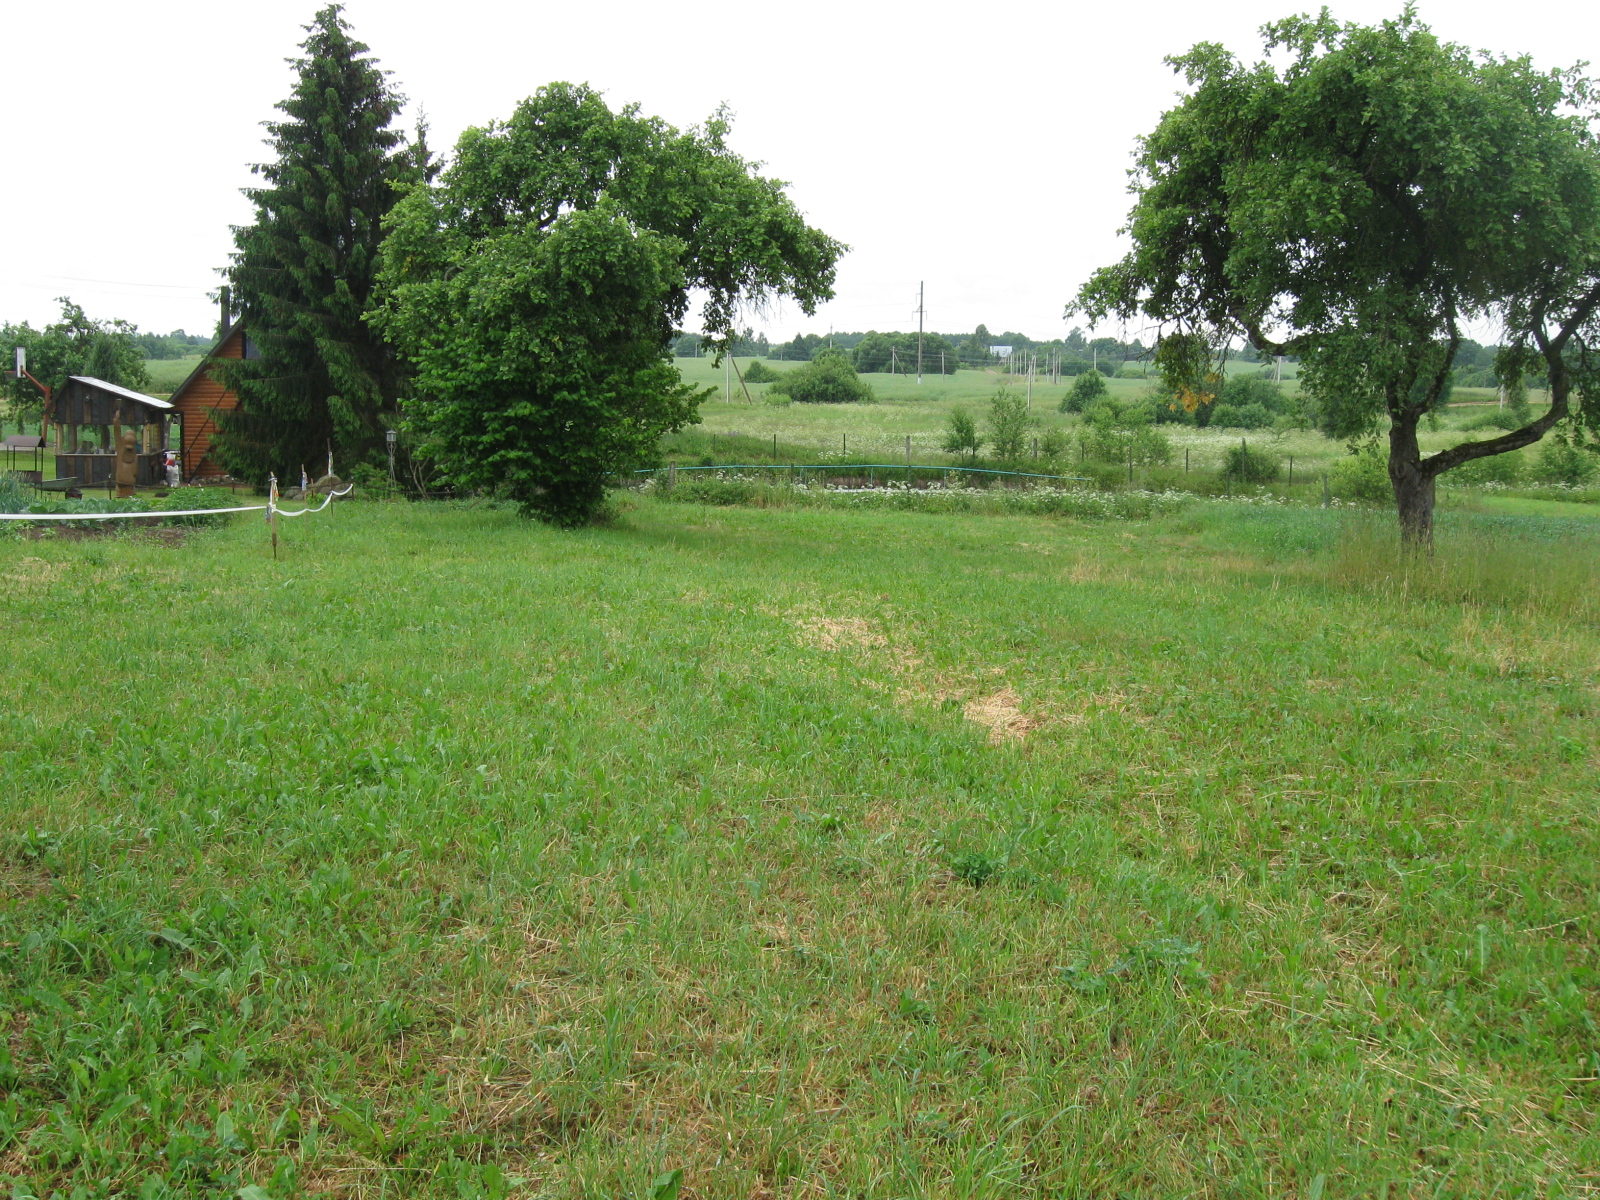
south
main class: Cropland
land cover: Apple fruit
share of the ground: < 10 %
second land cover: Grassland without tree/shrub cover
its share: > 75 %
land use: Agriculture (excluding fallow land and kitchen gardens)
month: June
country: LT
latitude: 54.7677
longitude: 24.3840
